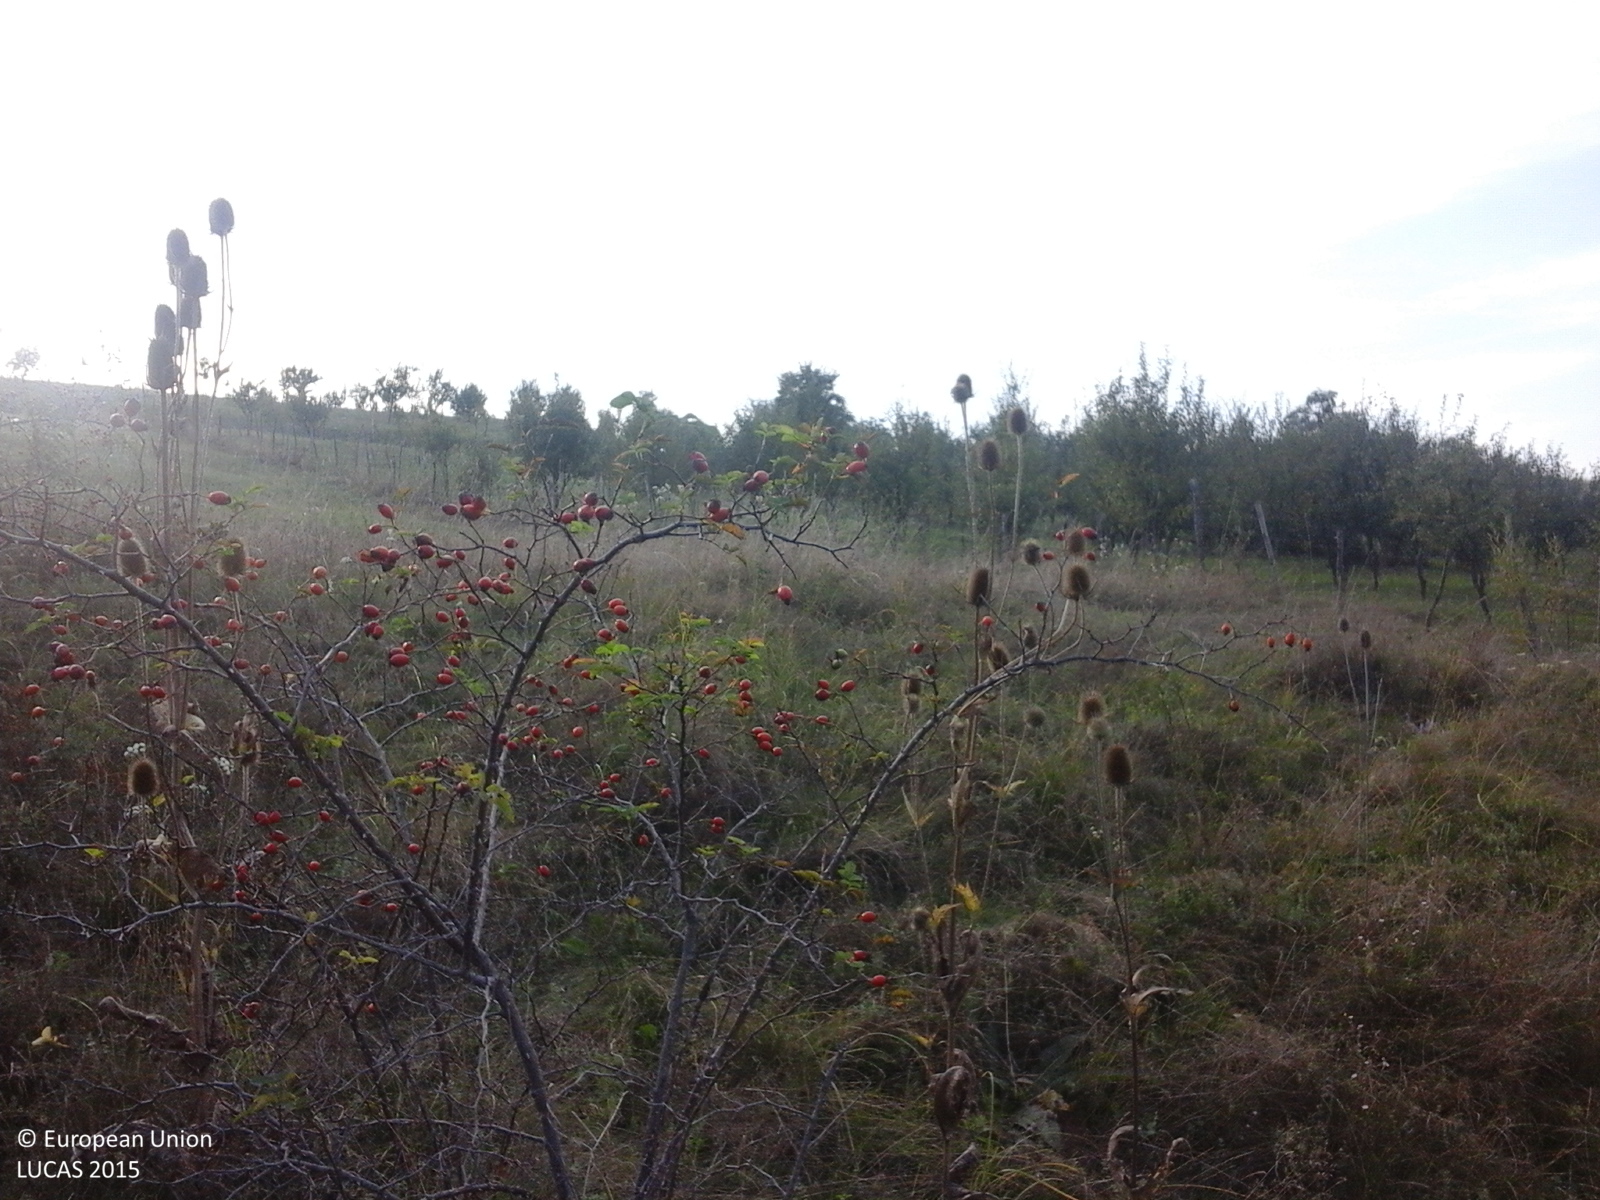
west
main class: Grassland
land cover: Grassland with sparse tree/shrub cover
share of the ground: > 75 %
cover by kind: herbaceous plants 85 %, shrubs 10 %, broadleaved forest trees 5 %
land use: Fallow land
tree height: < 5 m
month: September
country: RO
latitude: 46.8269
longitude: 23.0264
